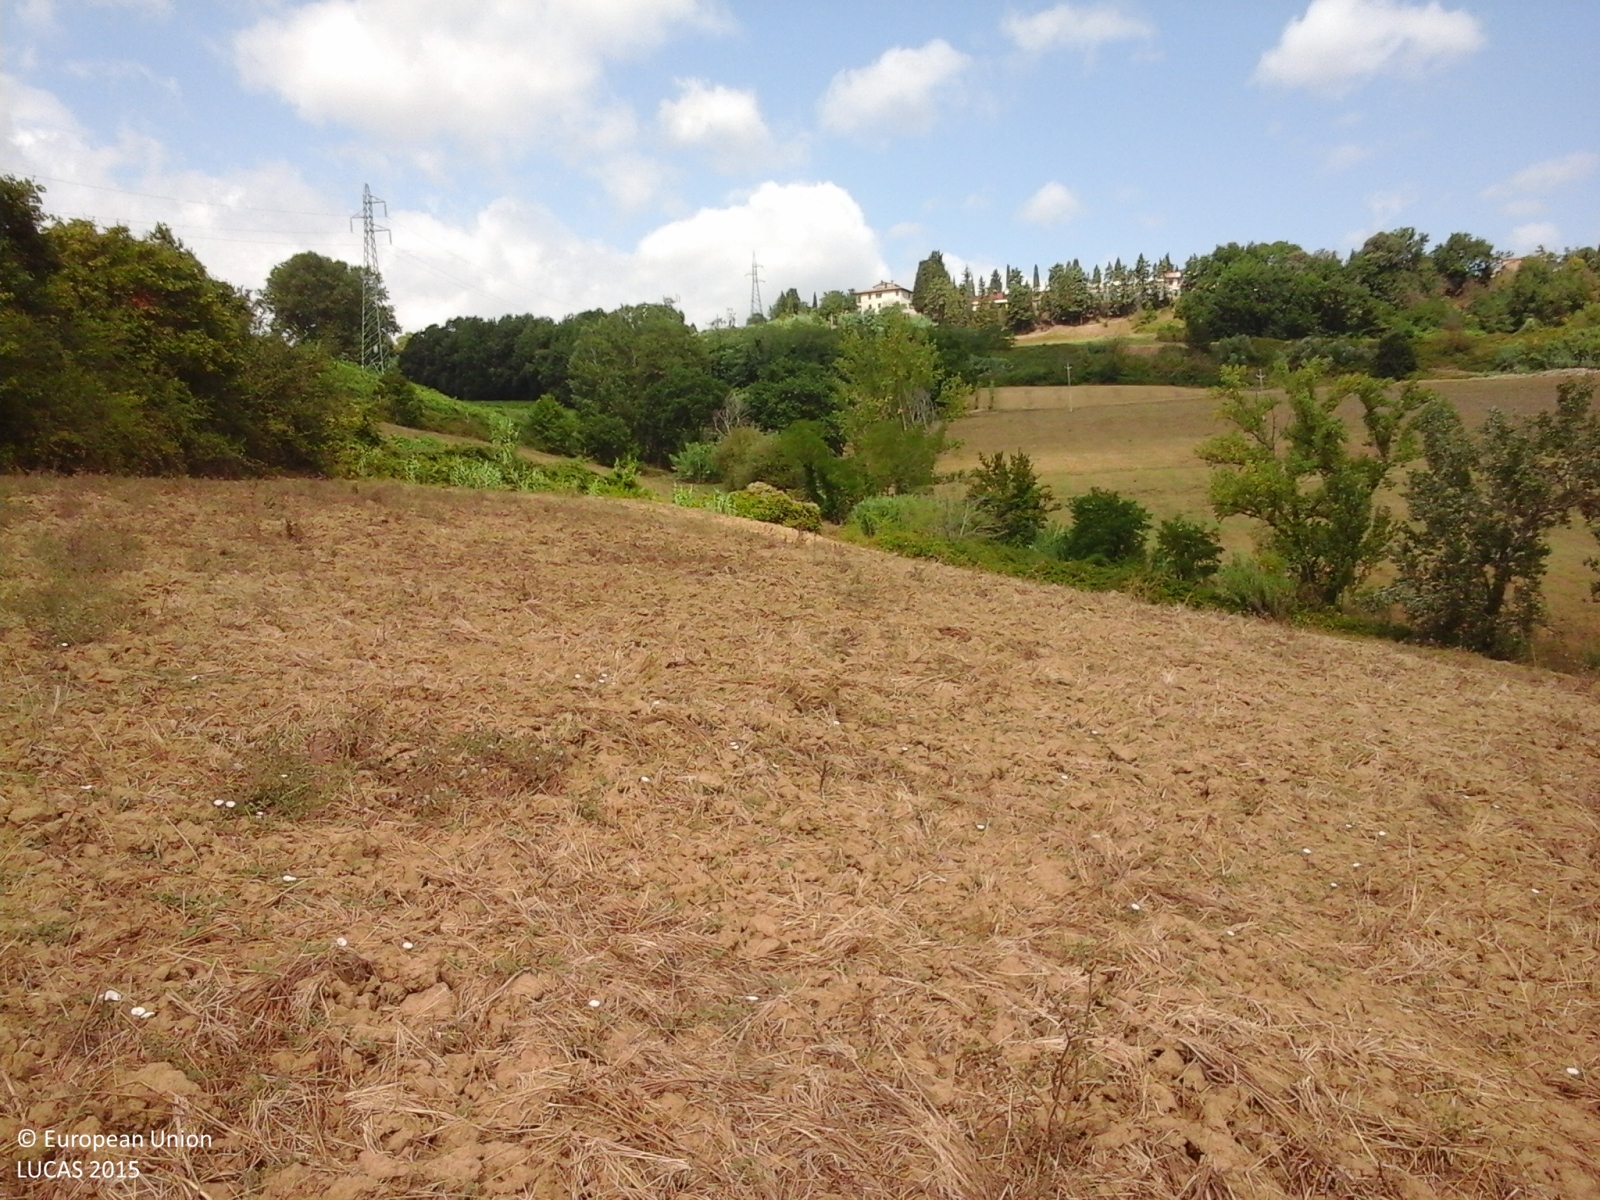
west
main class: Grassland
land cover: Grassland without tree/shrub cover
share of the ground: > 75 %
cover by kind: herbaceous plants 100 %
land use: Agriculture (excluding fallow land and kitchen gardens)
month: July
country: IT
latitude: 43.5150
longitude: 11.0732
